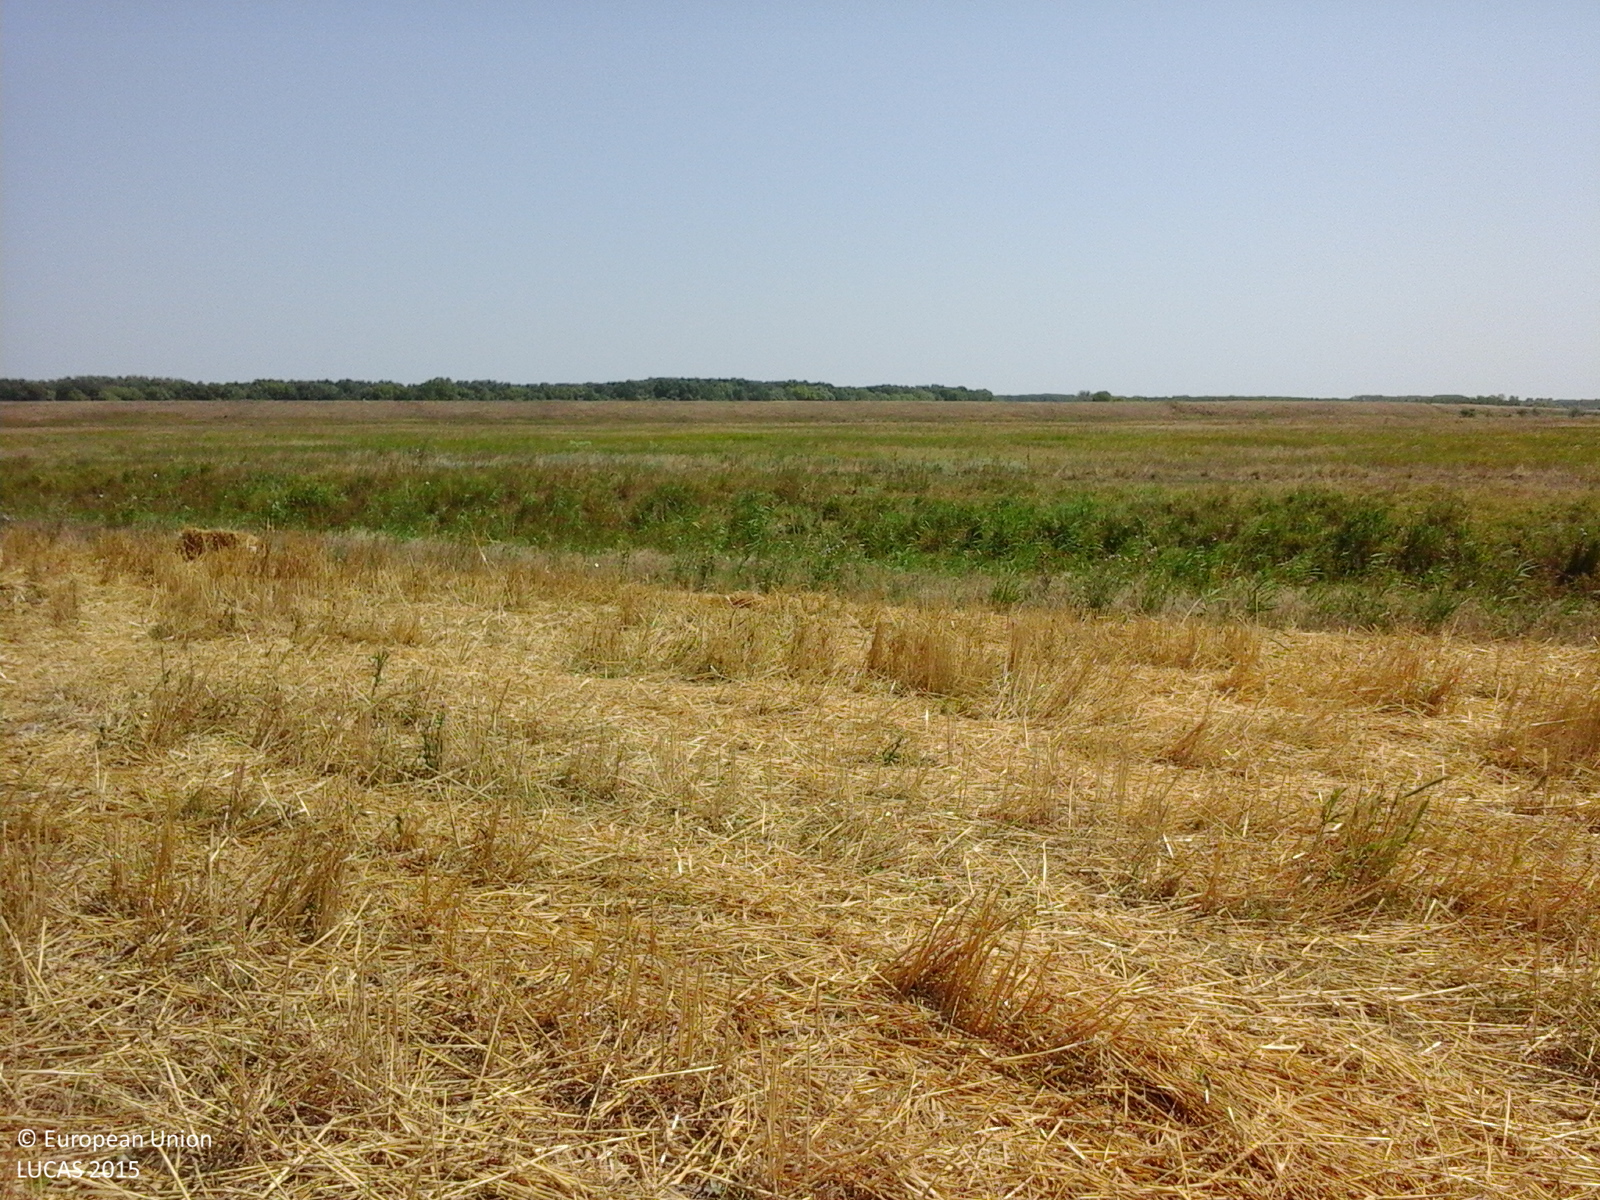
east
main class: Cropland
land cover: Common wheat
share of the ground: < 10 %
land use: Agriculture (excluding fallow land and kitchen gardens)
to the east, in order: Common wheat; Ditches and canals; Grassland without tree/shrub cover
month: August
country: RO
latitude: 45.5337
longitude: 27.6372
